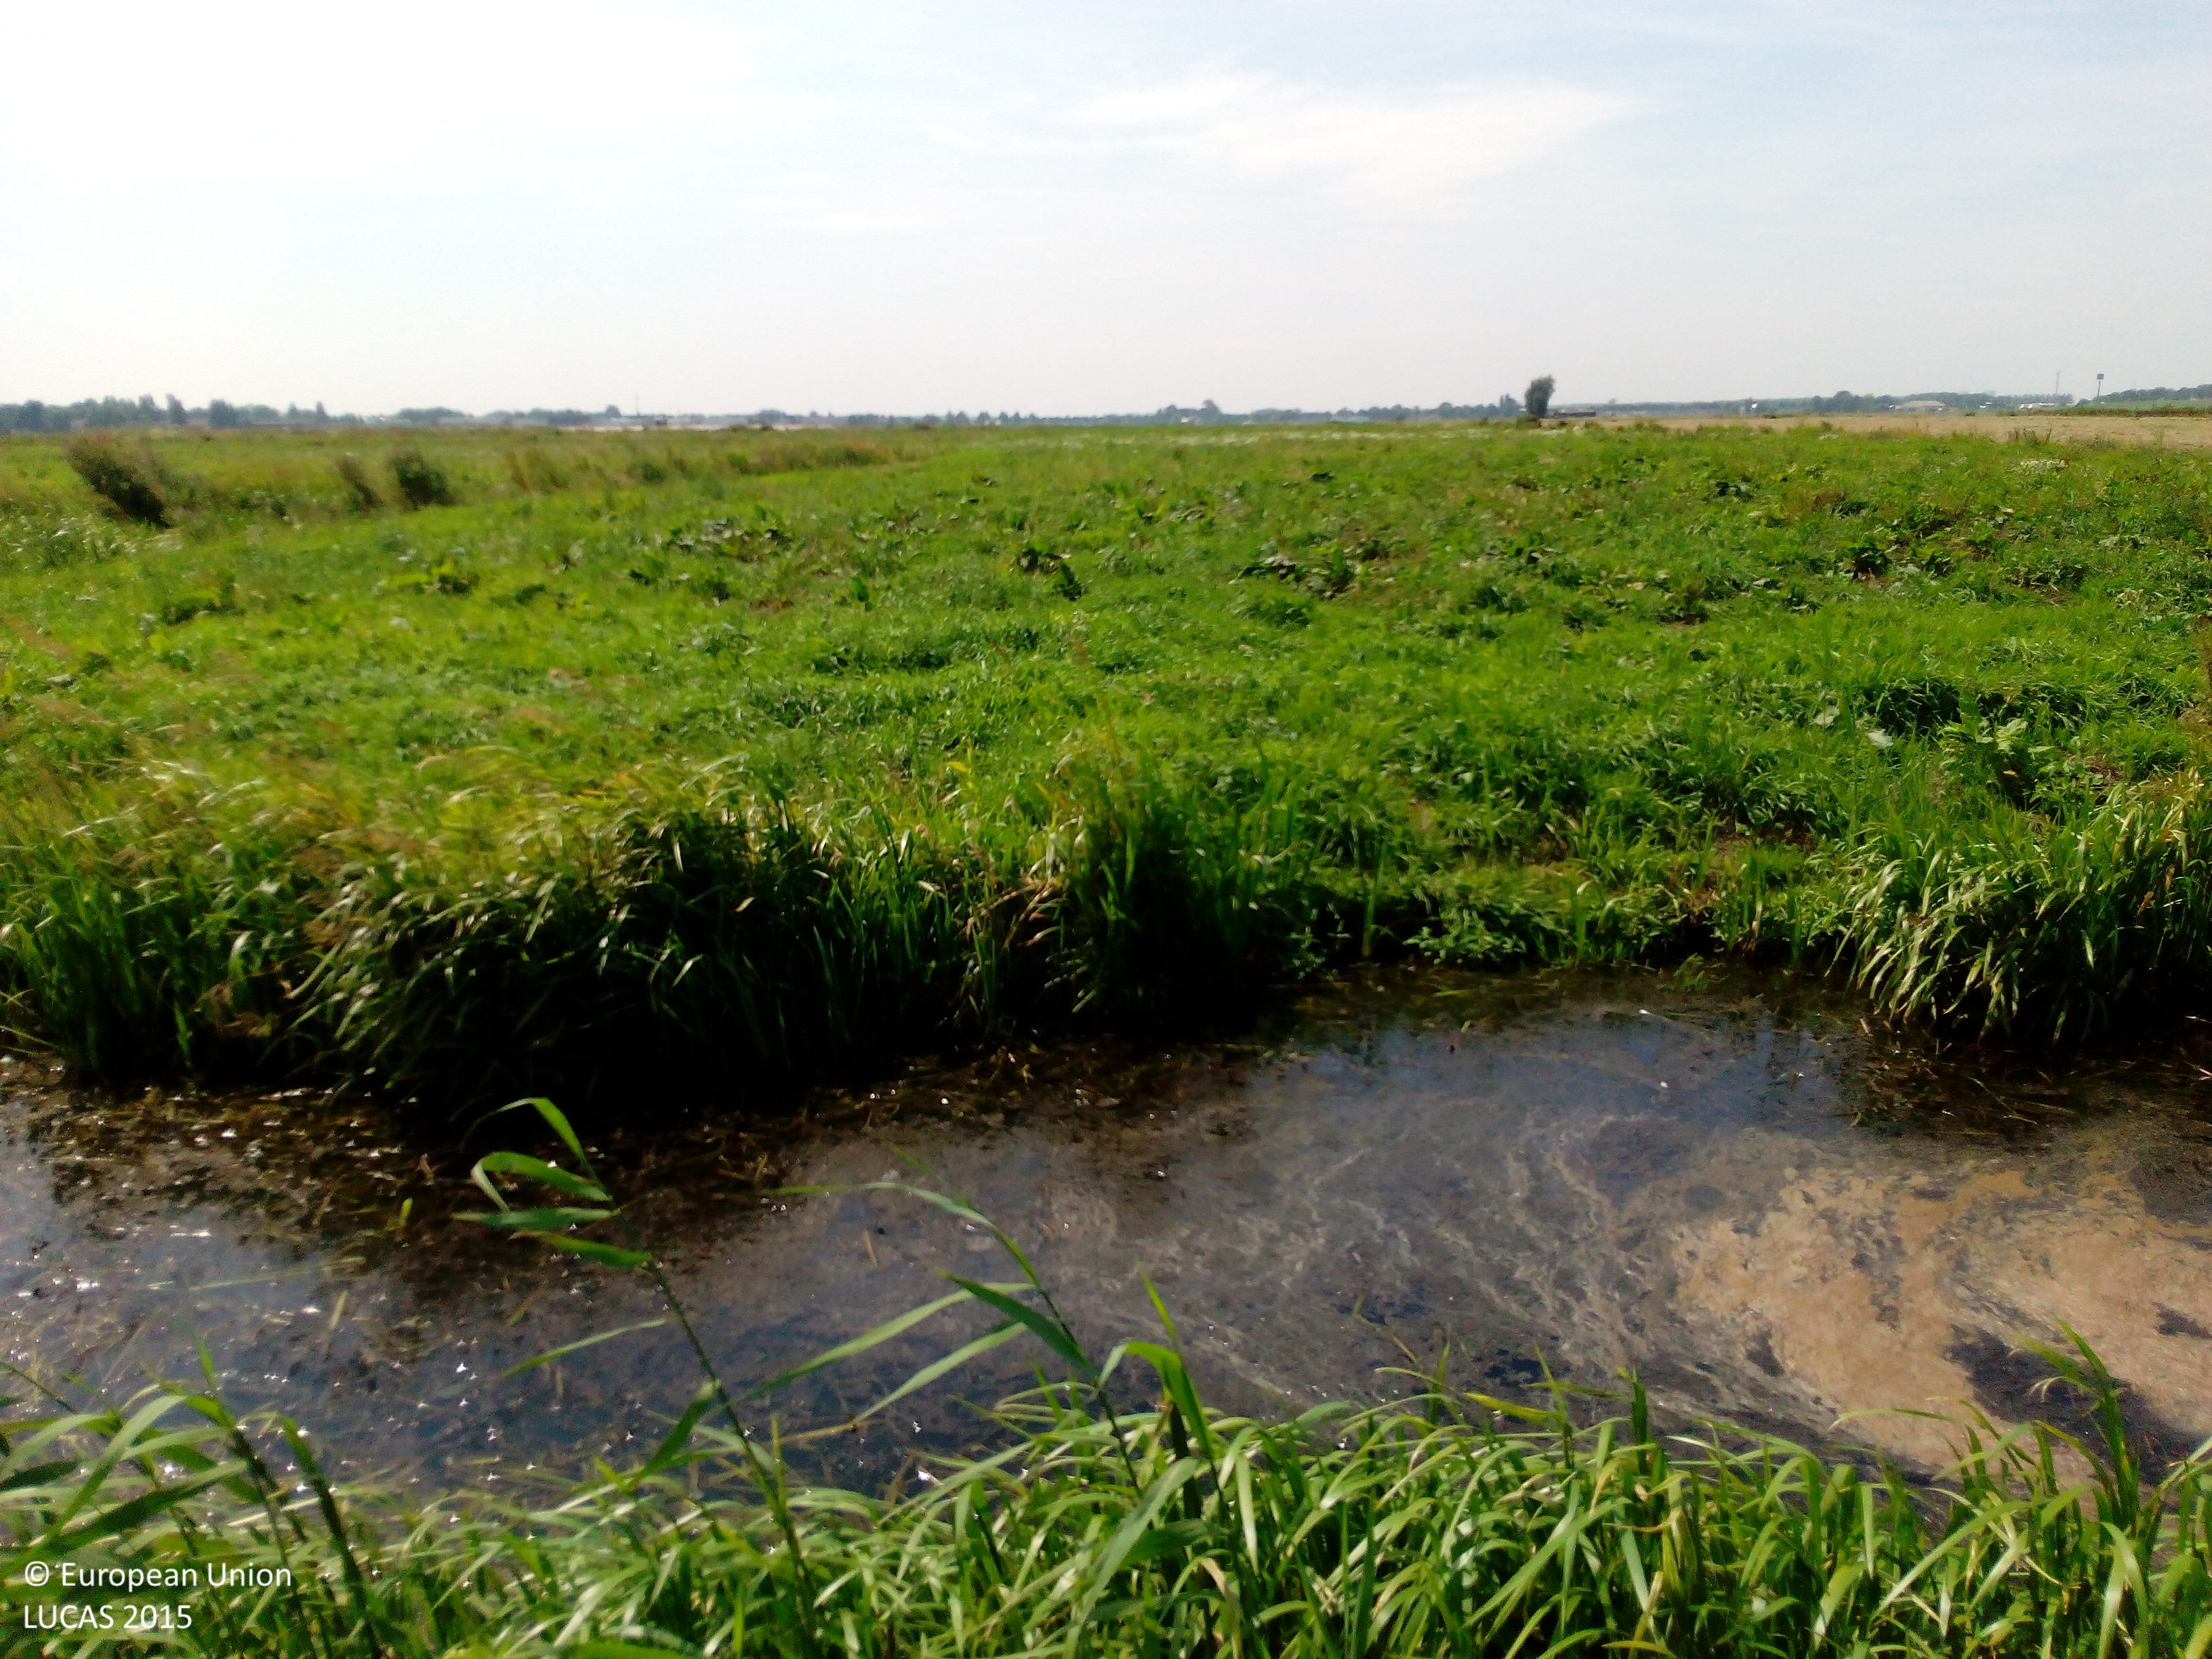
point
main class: Grassland
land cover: Grassland without tree/shrub cover
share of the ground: > 75 %
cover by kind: herbaceous plants 80 %, unconsolidated bare surface 20 %
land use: Agriculture (excluding fallow land and kitchen gardens)
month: August
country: NL
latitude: 52.0060
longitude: 4.6792
